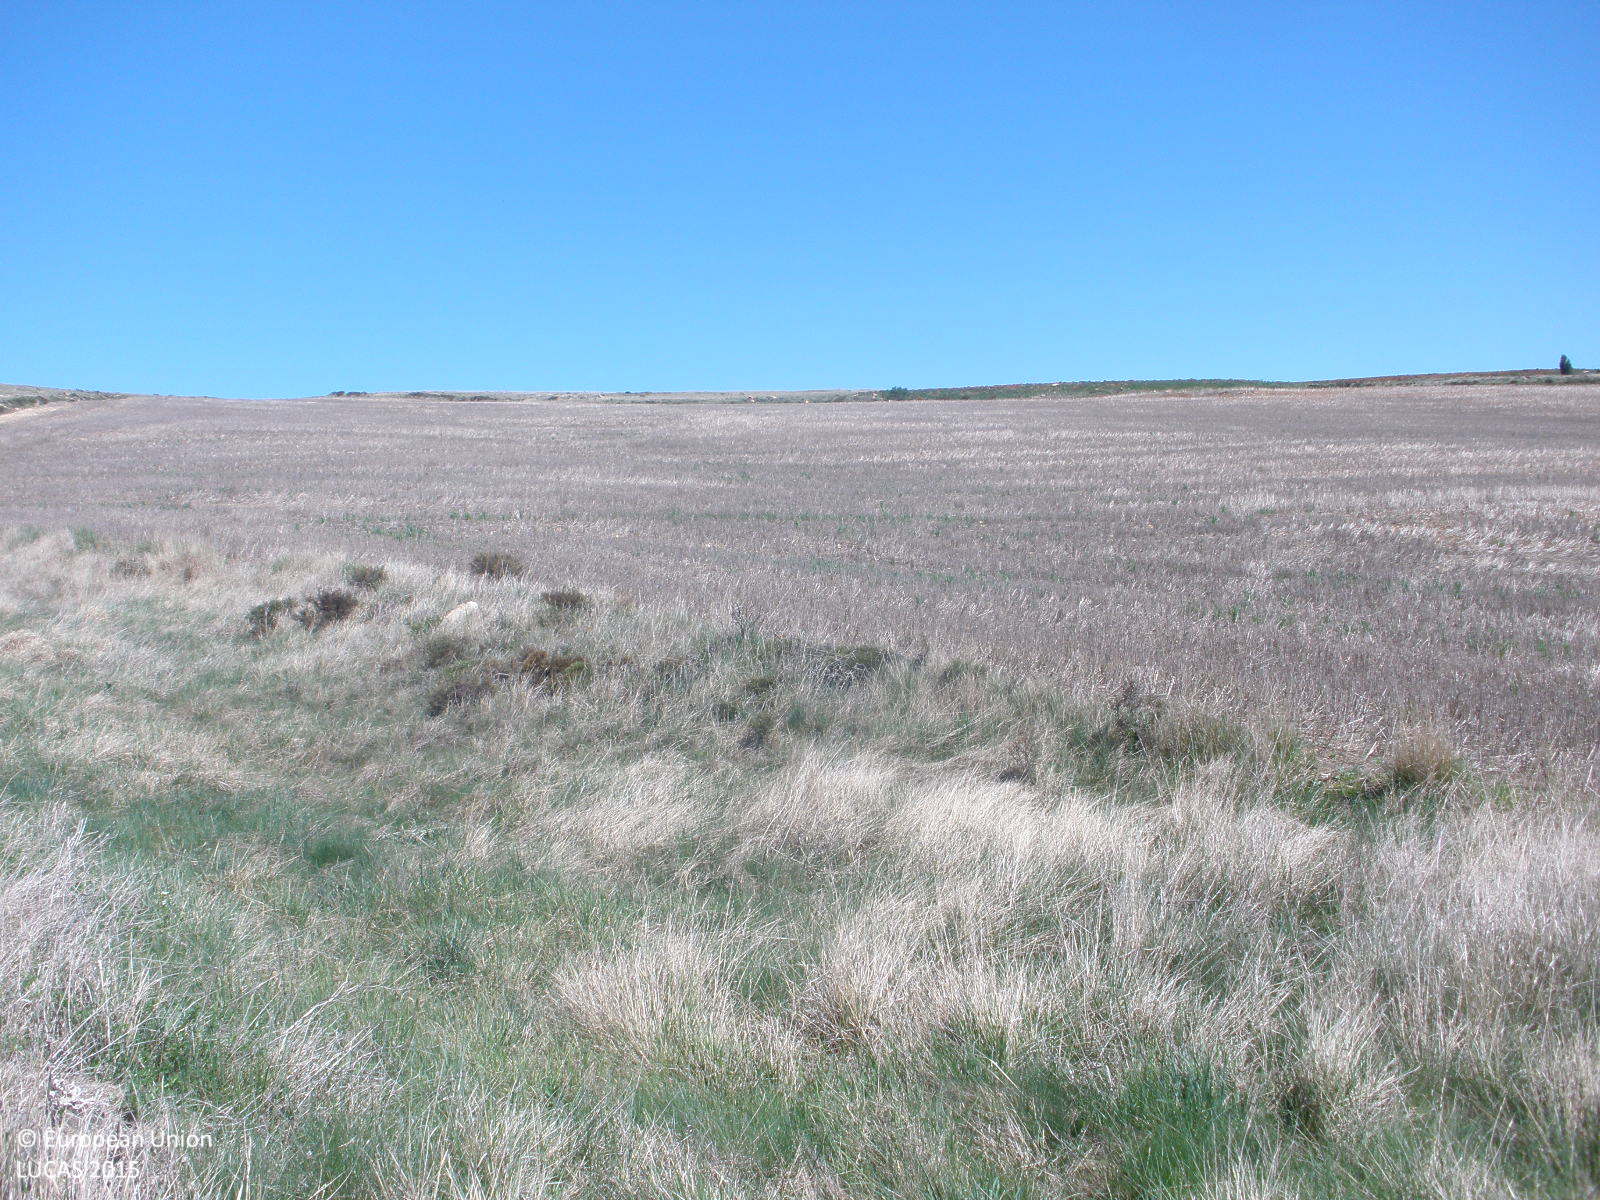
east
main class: Grassland
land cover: Spontaneously vegetated surfaces
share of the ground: 25 - 50 %
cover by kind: unconsolidated bare surface 75 %, herbaceous plants 25 %
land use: Agriculture (excluding fallow land and kitchen gardens)
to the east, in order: Spontaneously vegetated surfaces; Grassland without tree/shrub cover; Spontaneously vegetated surfaces; Grass margins
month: May
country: ES
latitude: 40.7271
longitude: -0.7985
